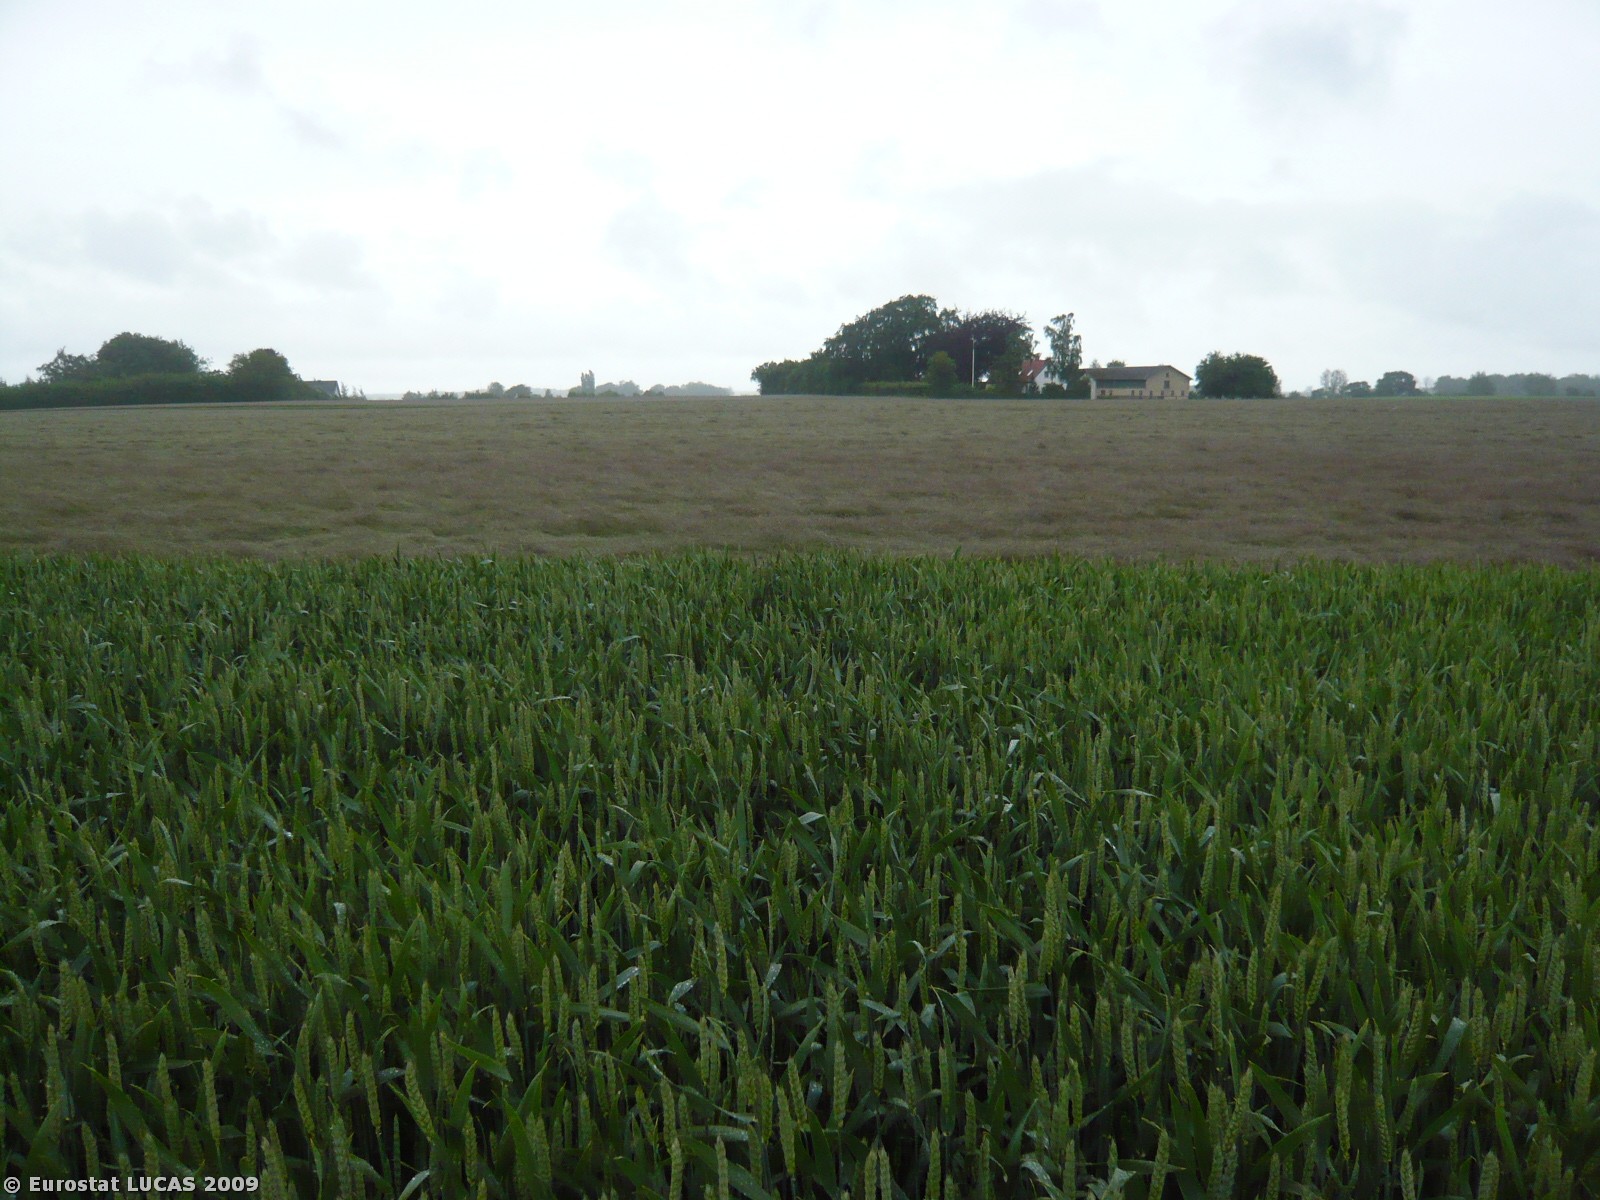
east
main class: Cropland
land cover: Common wheat
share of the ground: > 75 %
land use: Agriculture (excluding fallow land and kitchen gardens)
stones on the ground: 10 - 25 %
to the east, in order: Common wheat; Temporary grasslands
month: June
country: DK
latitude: 54.7882
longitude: 11.9738
